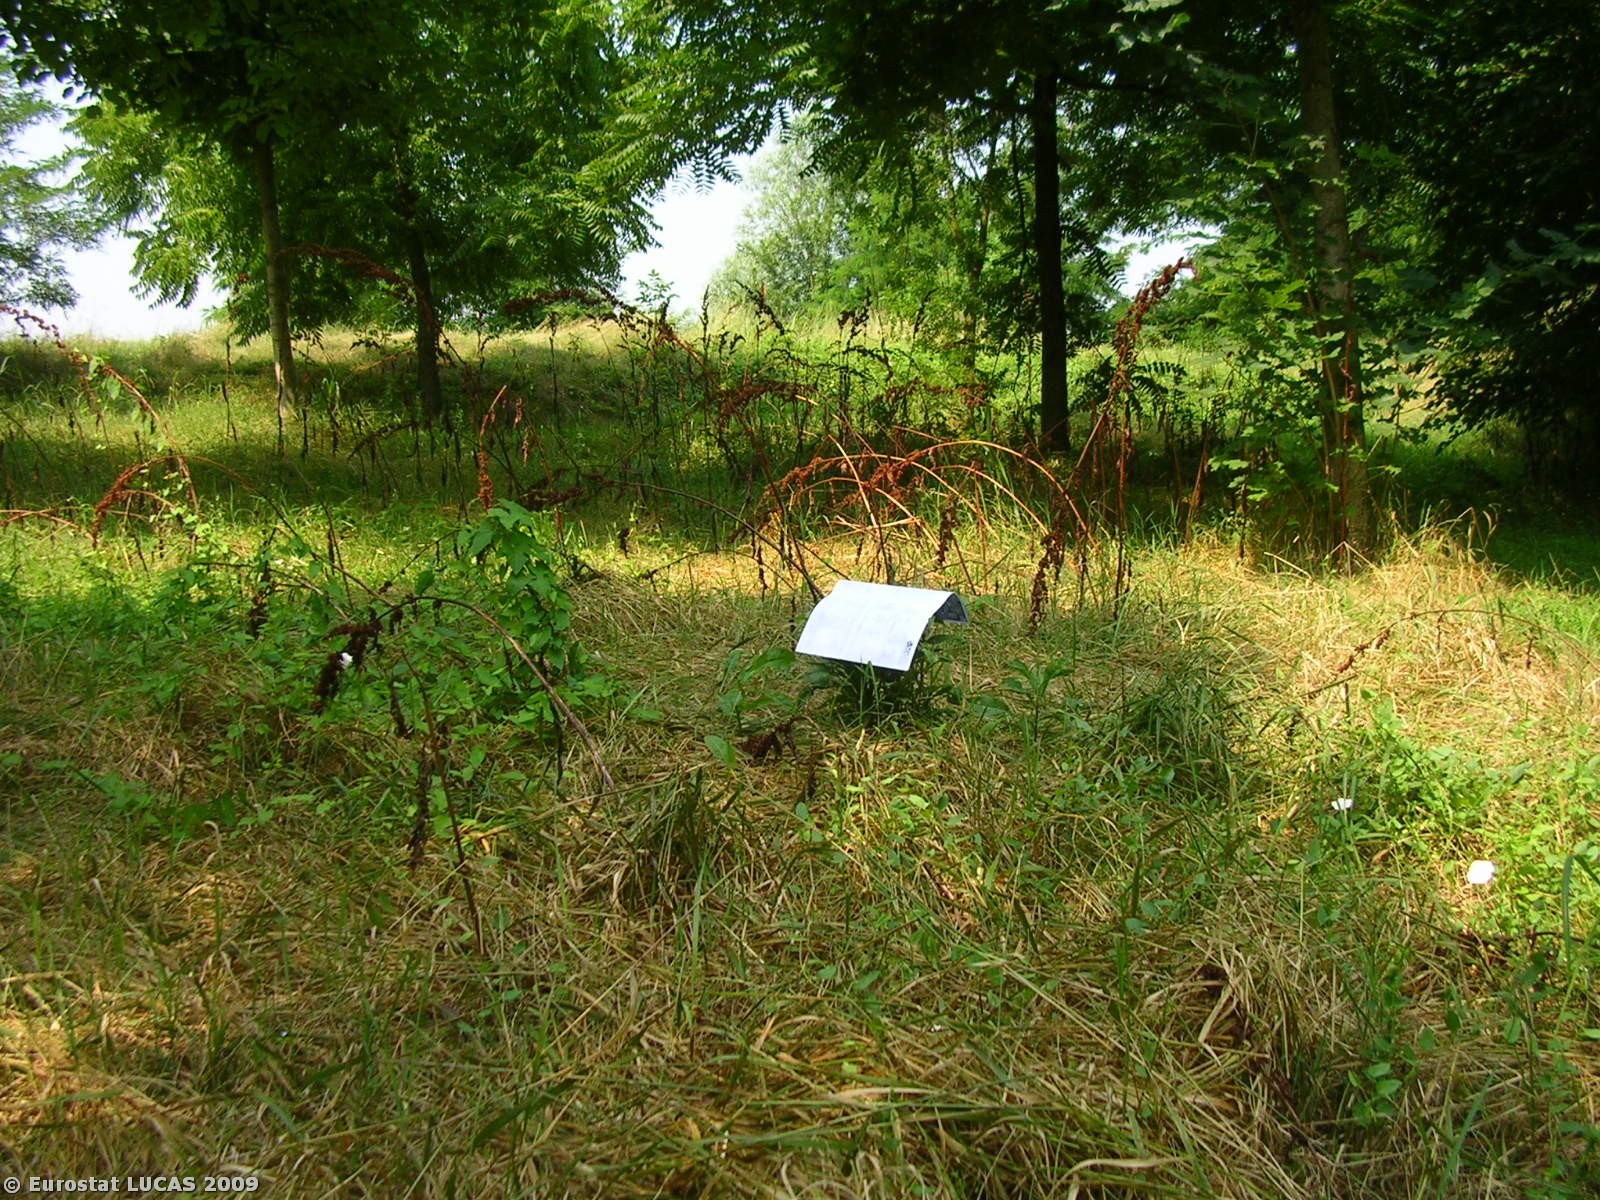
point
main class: Woodland
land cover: Broadleaved woodland
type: non-riverine alder, birch or aspen forest
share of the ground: > 75 %
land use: Agriculture (excluding fallow land and kitchen gardens)
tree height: > 5 m
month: July
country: IT
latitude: 45.2213
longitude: 11.6399
